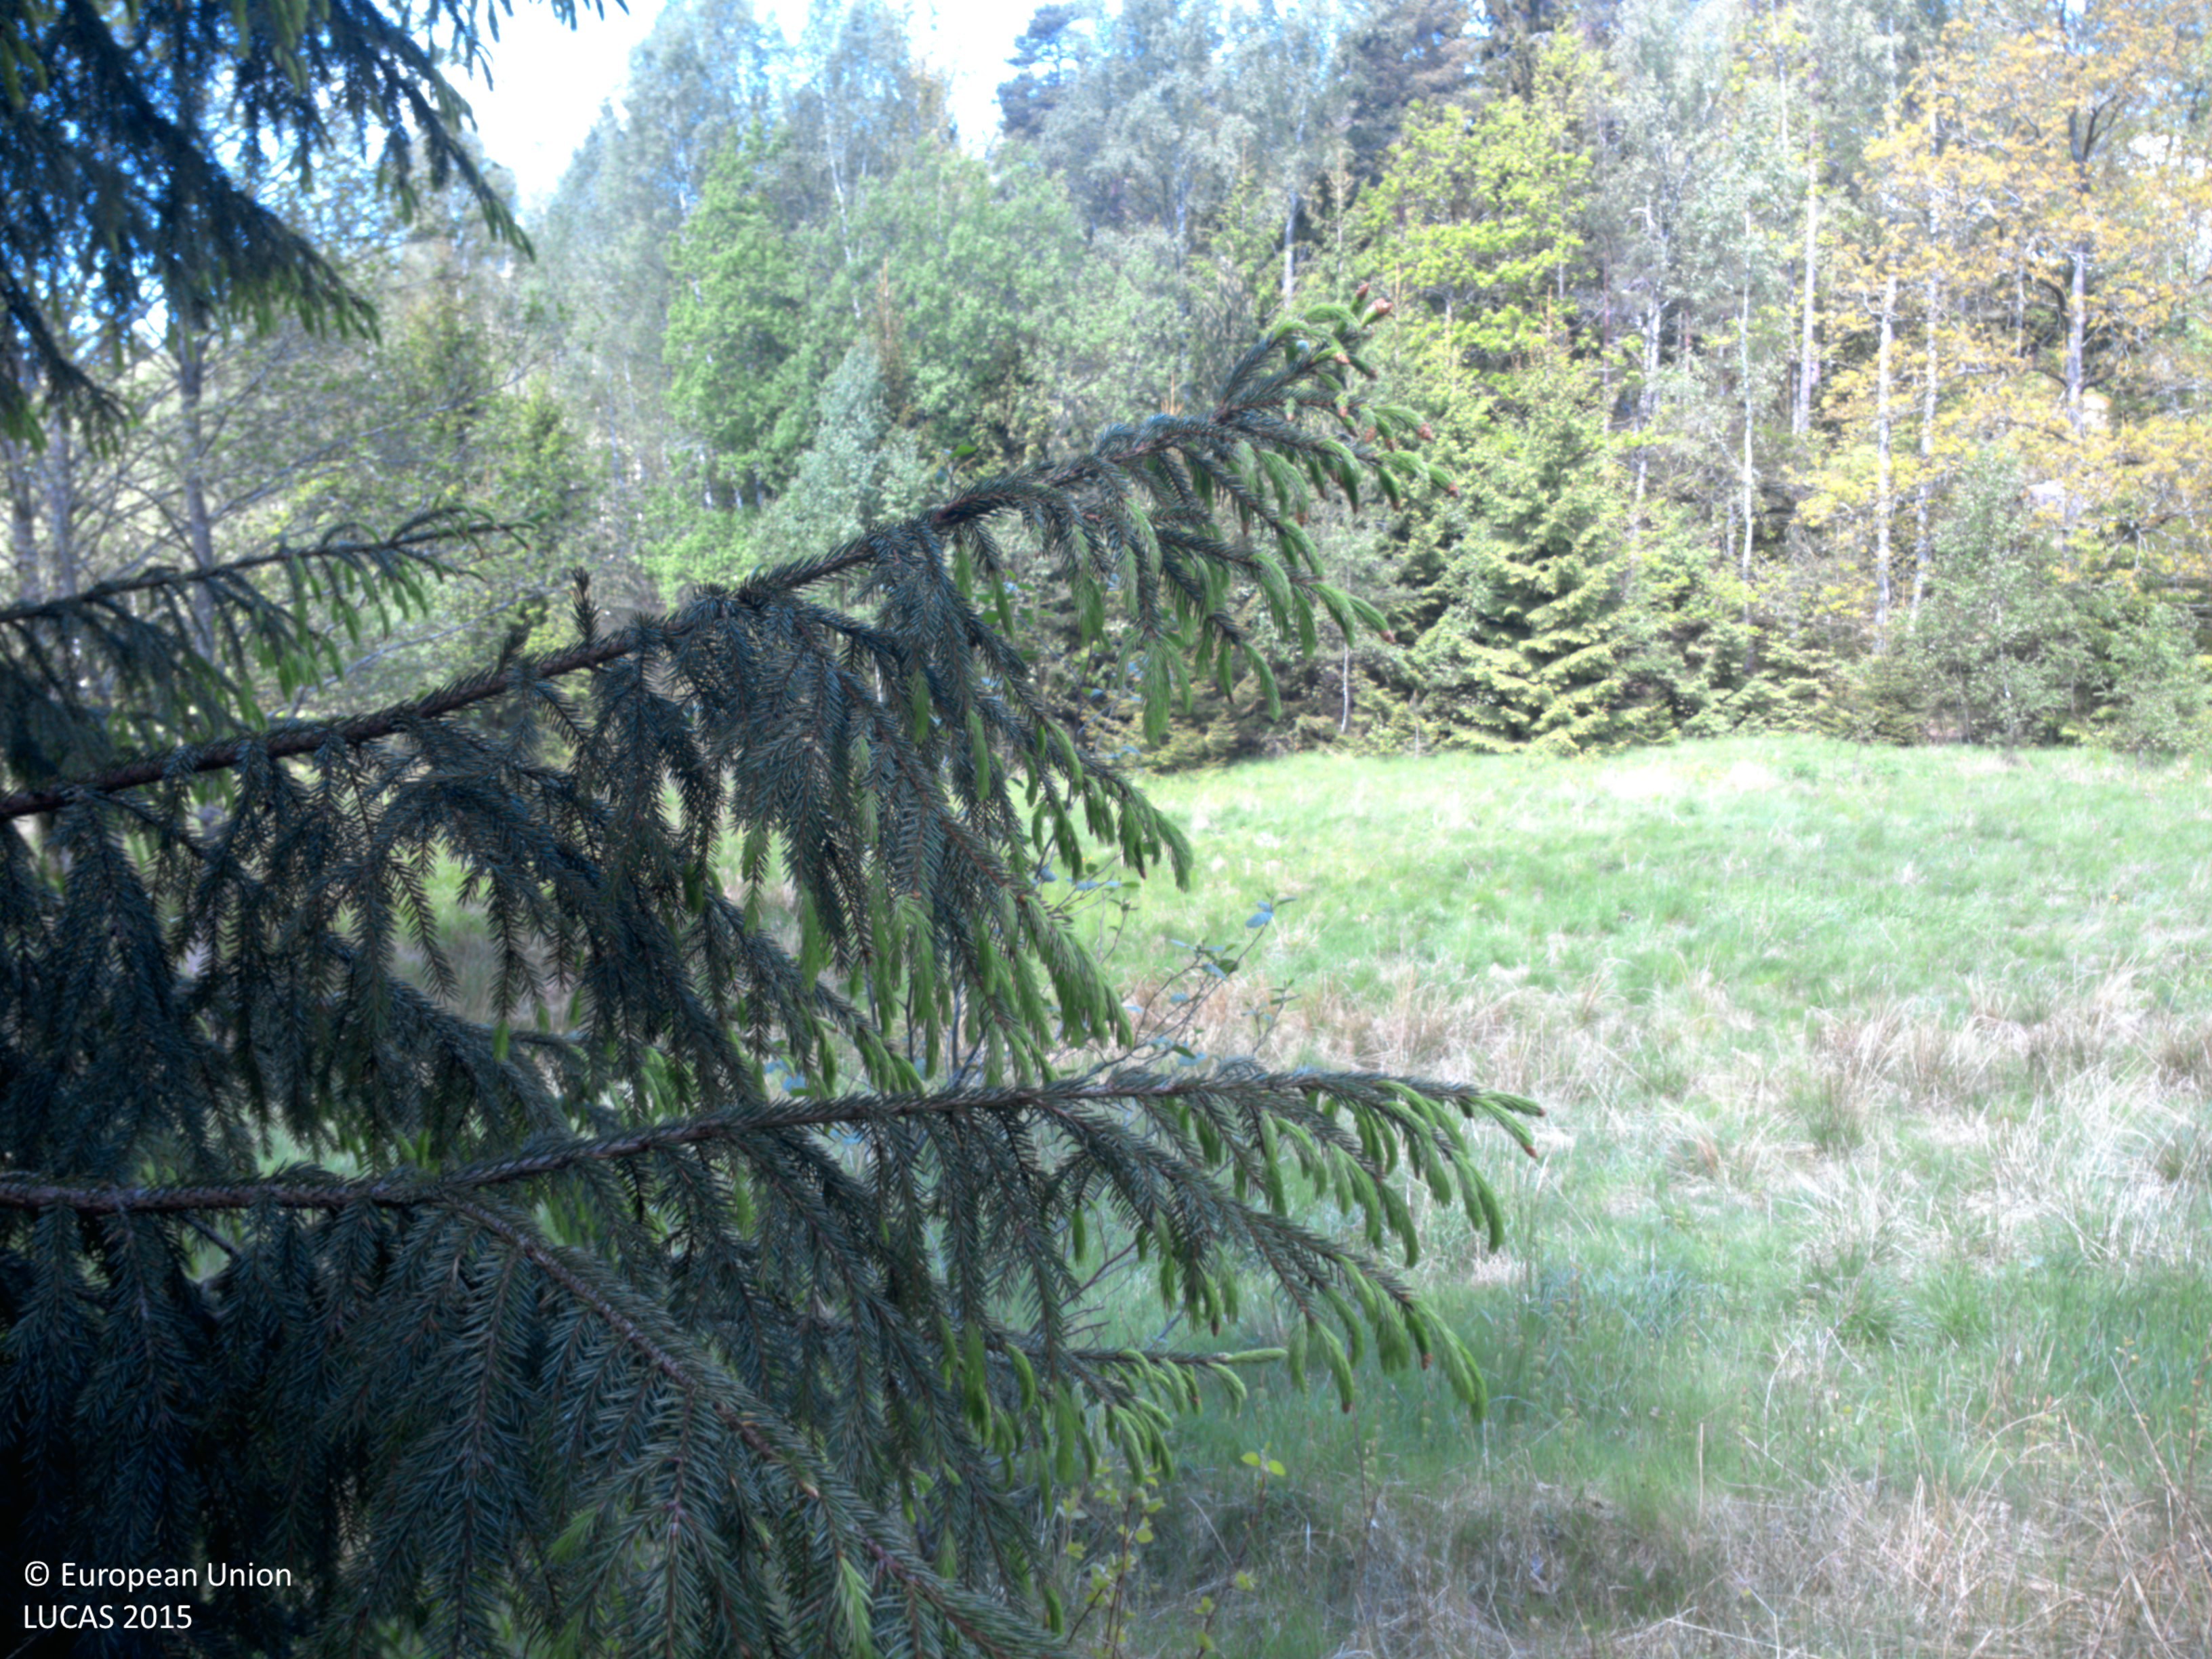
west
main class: Woodland
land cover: Spruce dominated mixed woodland
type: boreal forest
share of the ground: 25 - 50 %
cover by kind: herbaceous plants 50 %, coniferous forest trees 35 %, broadleaved forest trees 15 %
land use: Forestry
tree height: > 5 m
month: June
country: SE
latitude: 58.3137
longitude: 11.9250
